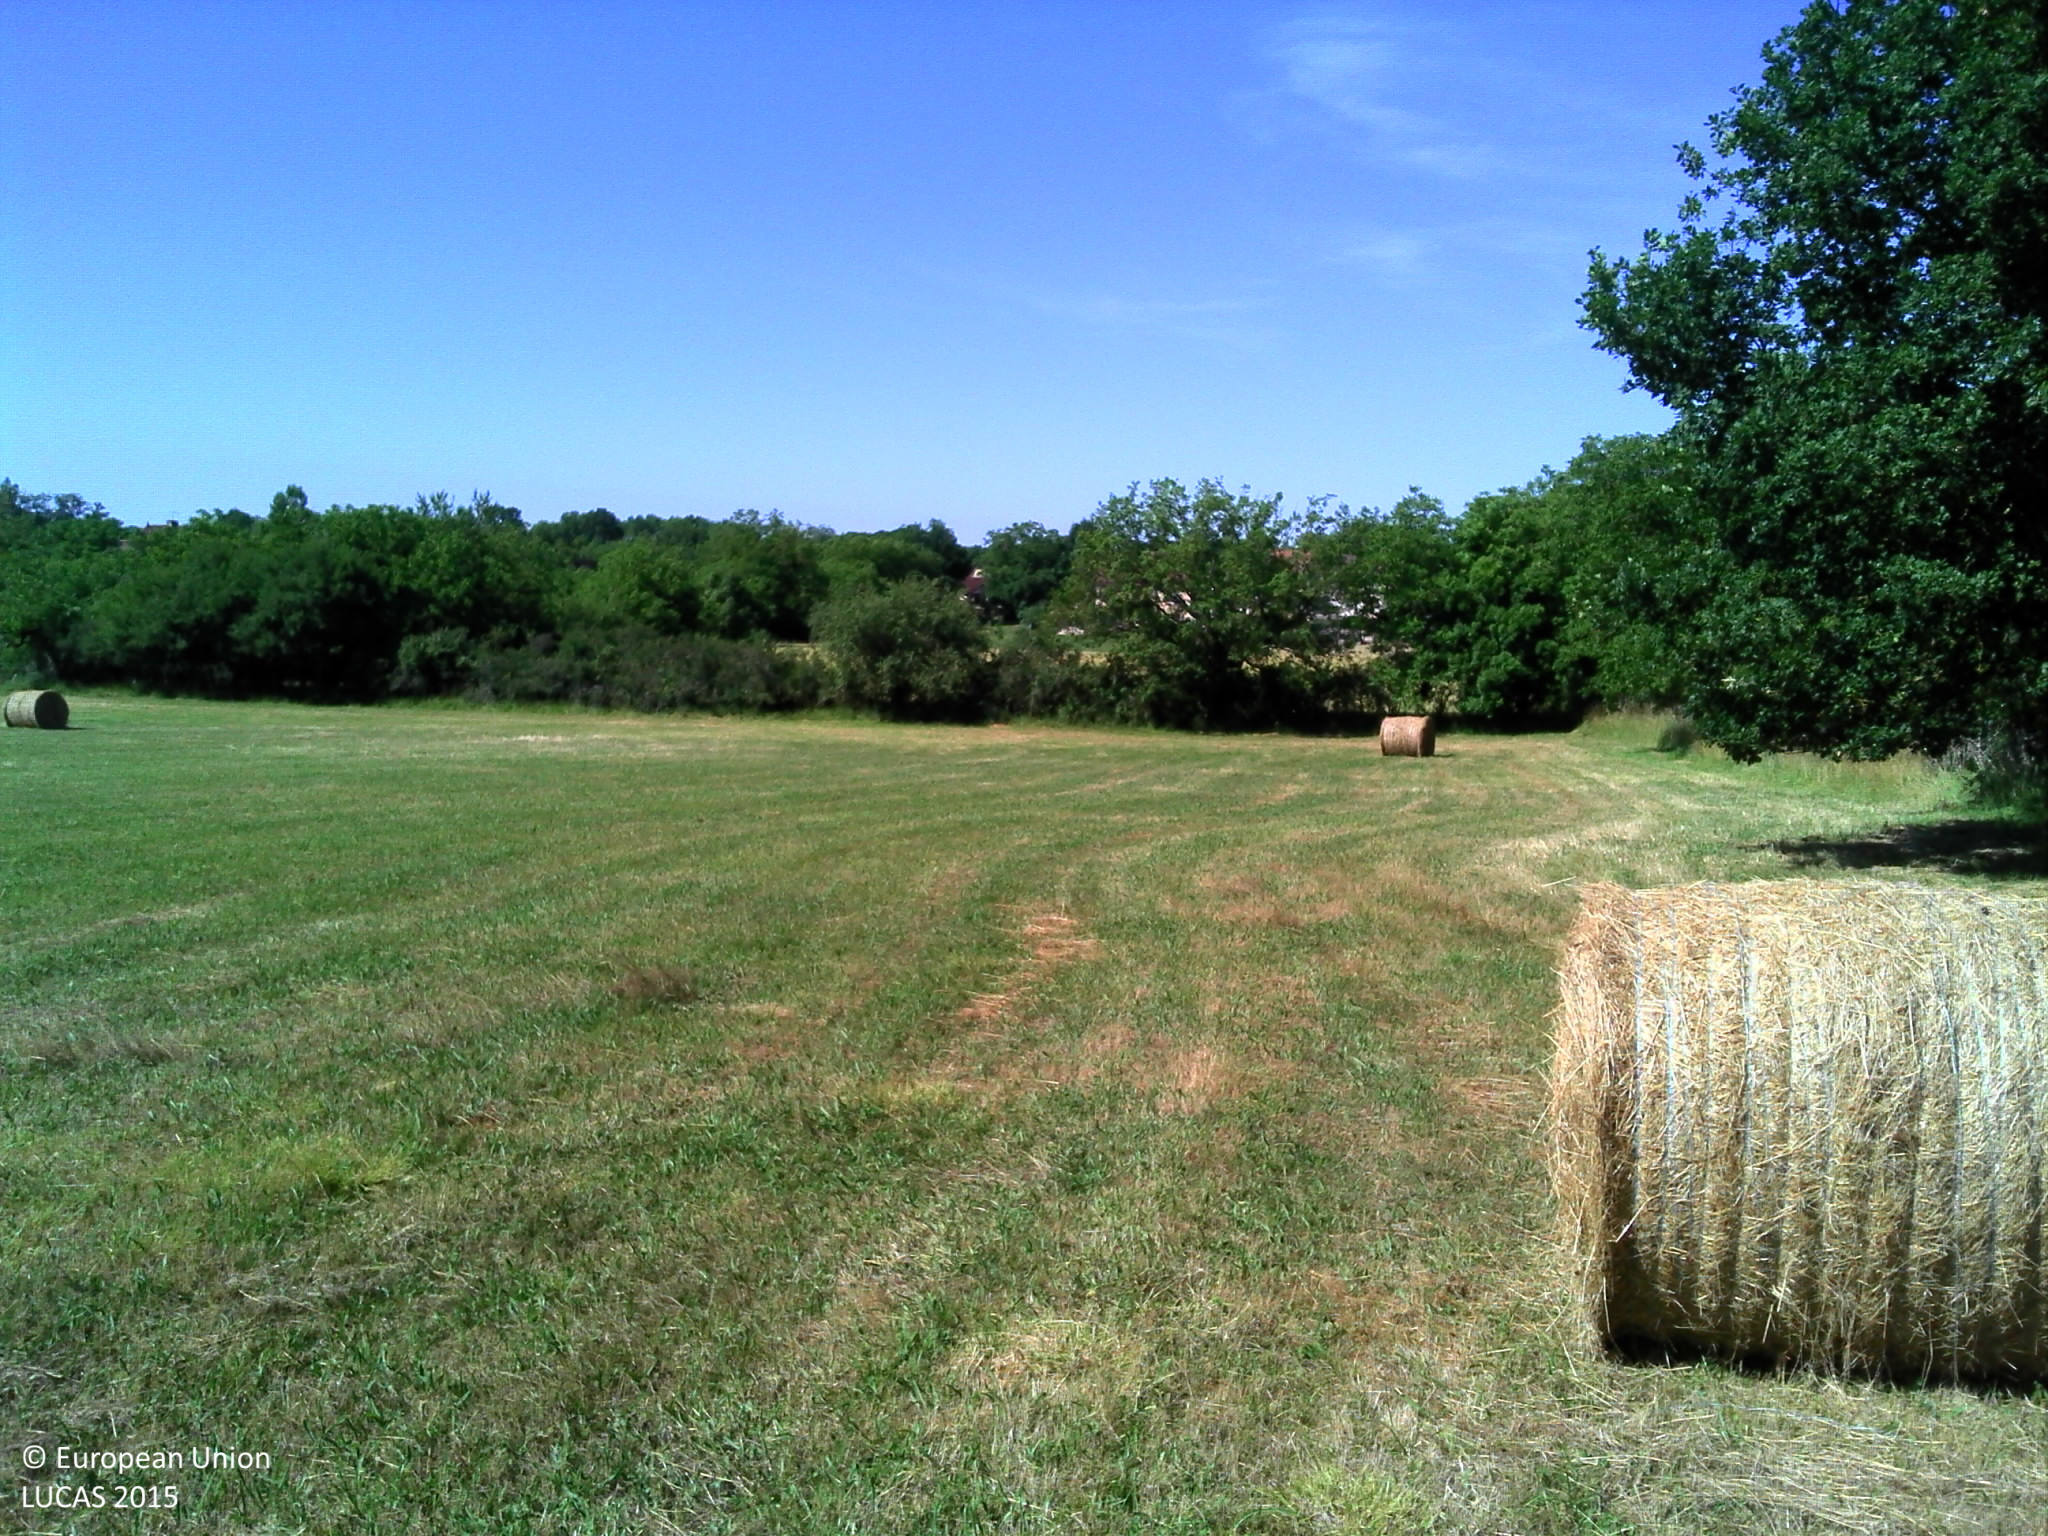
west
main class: Grassland
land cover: Grassland without tree/shrub cover
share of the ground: > 75 %
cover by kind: herbaceous plants 100 %
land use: Agriculture (excluding fallow land and kitchen gardens)
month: June
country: FR
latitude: 44.7504
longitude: 1.8009
